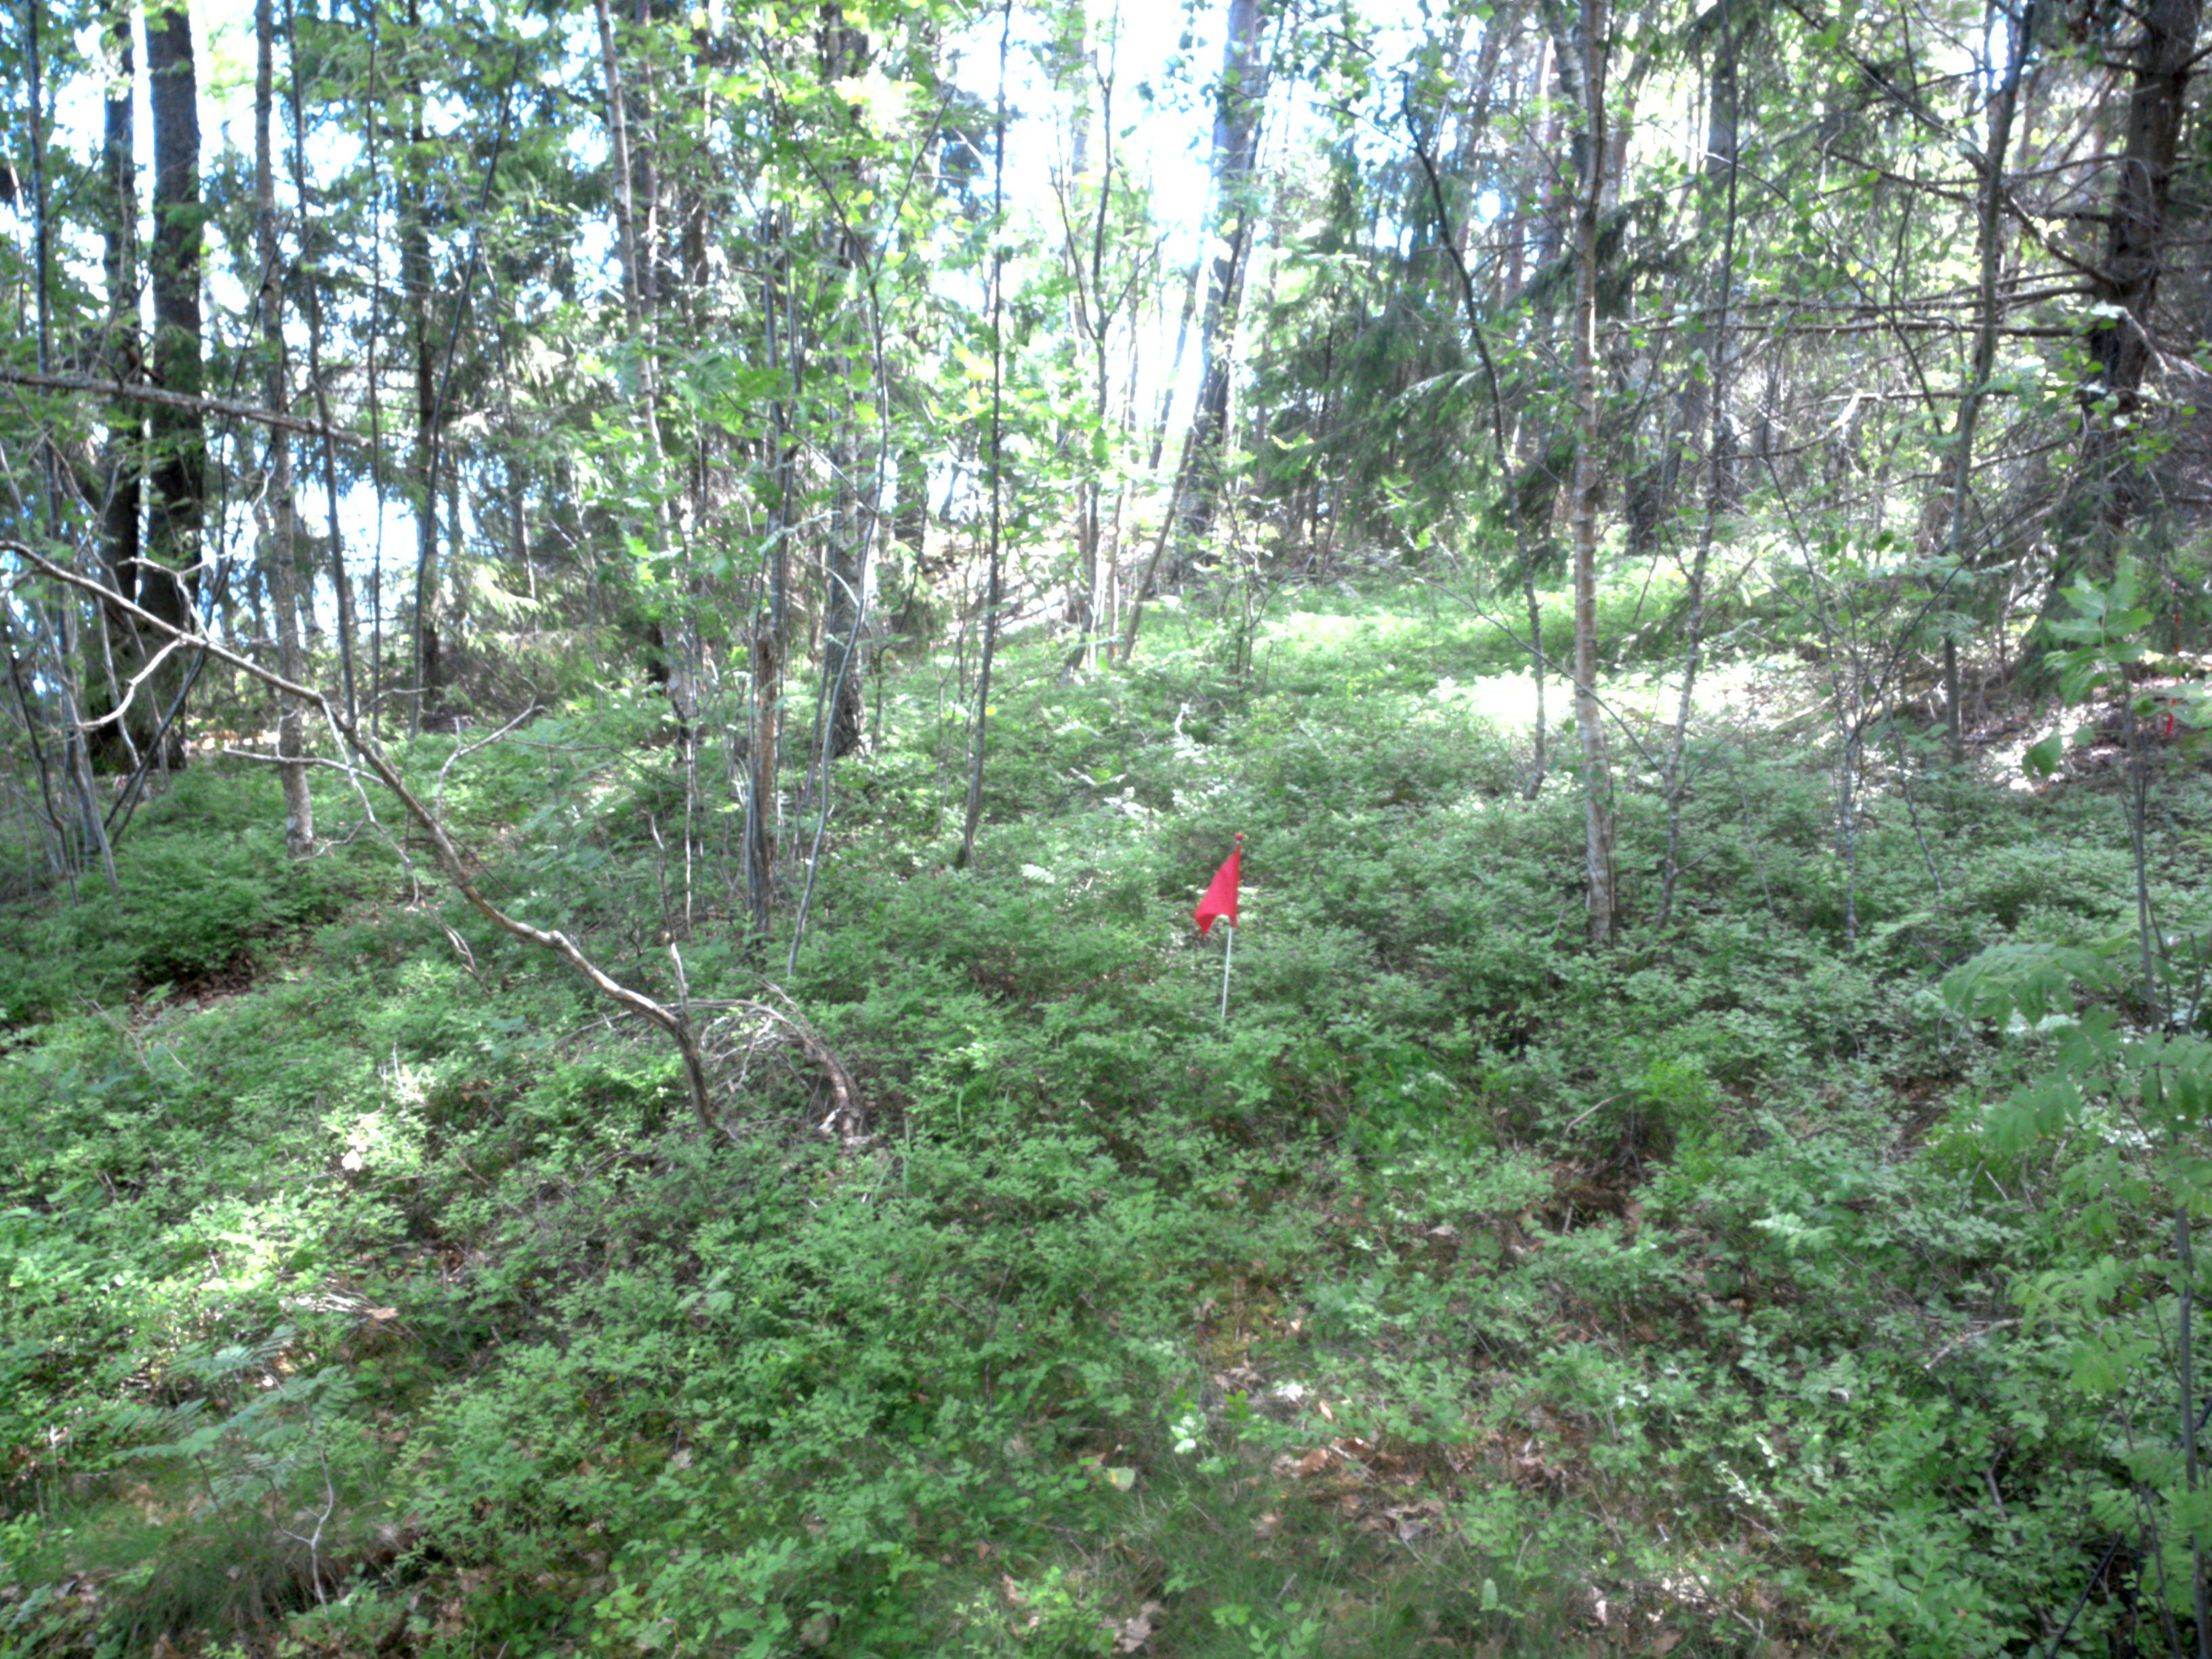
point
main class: Woodland
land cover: Broadleaved woodland
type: non-riverine alder, birch or aspen forest
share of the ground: > 75 %
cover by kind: broadleaved forest trees 80 %, coniferous forest trees 10 %, shrubs 5 %, herbaceous plants 5 %
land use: Forestry
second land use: Amenities, museums, leisure
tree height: > 5 m
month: June
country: SE
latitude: 59.3202
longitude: 17.6754
